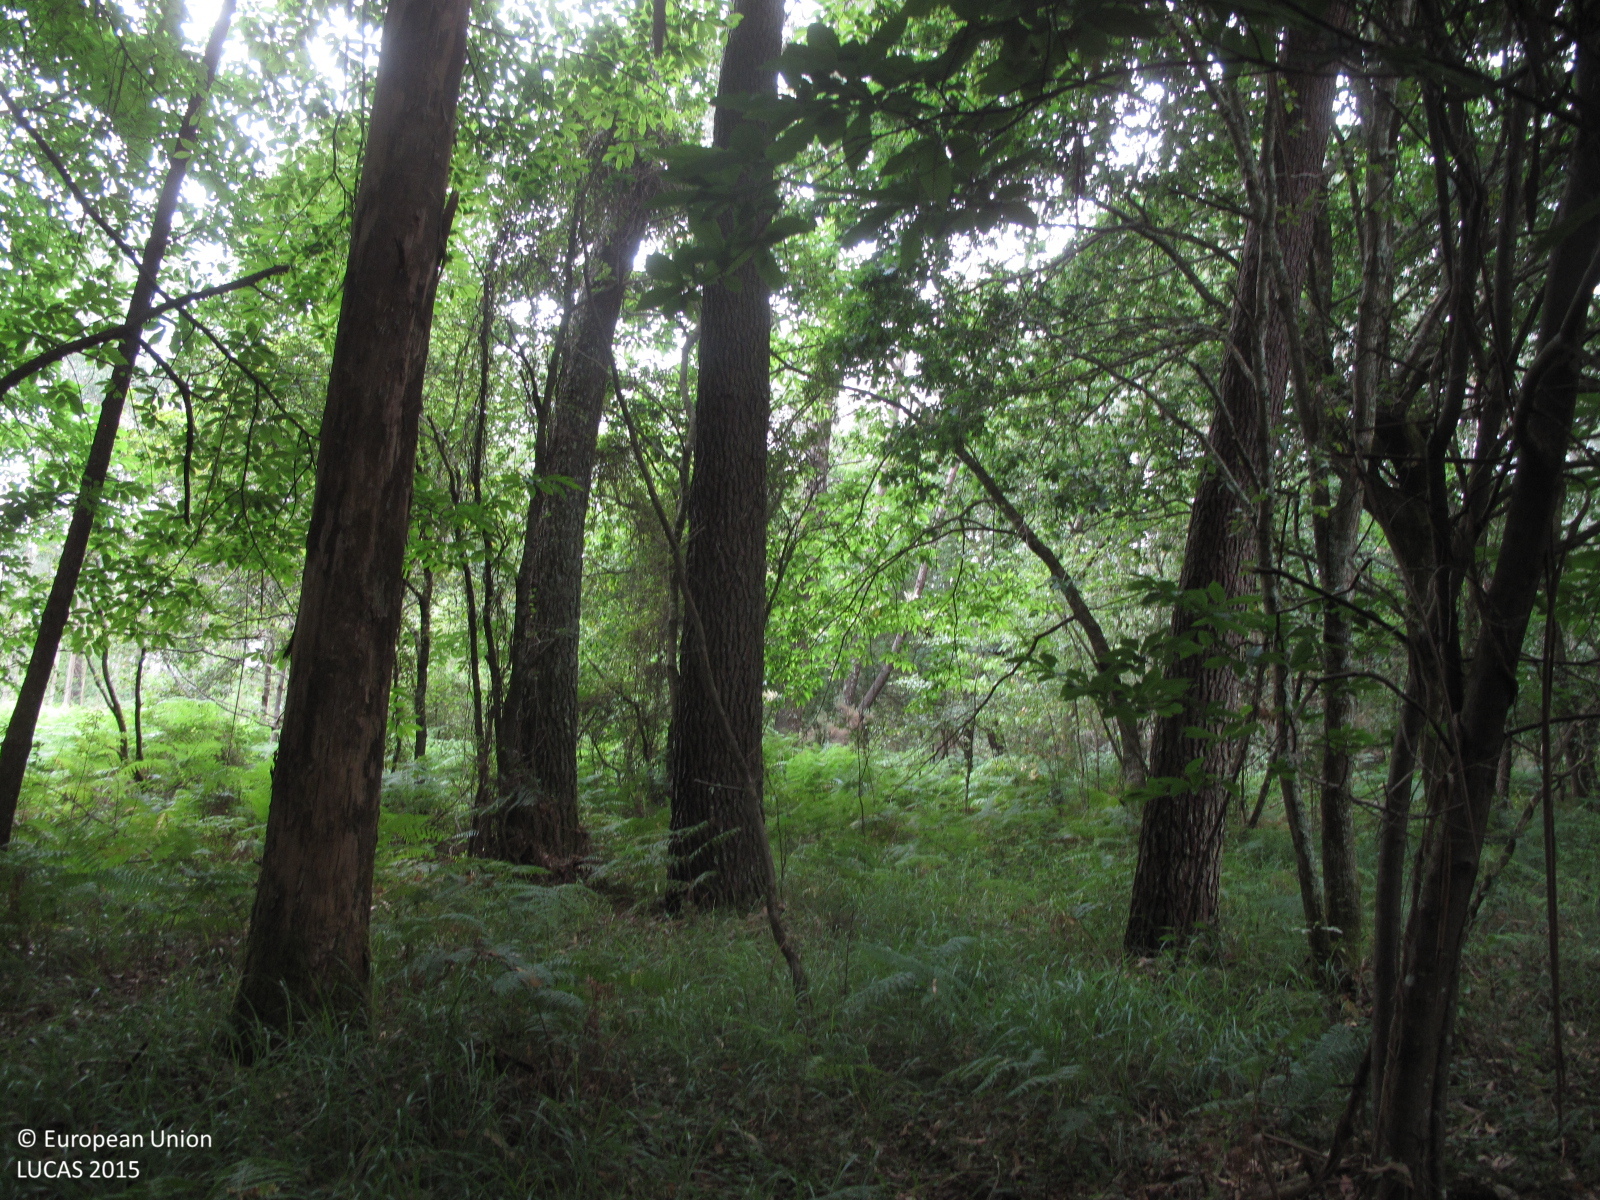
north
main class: Woodland
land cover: Broadleaved woodland
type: thermophilous deciduous forest
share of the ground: > 75 %
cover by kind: broadleaved forest trees 90 %, shrubs 5 %, herbaceous plants 5 %
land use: Forestry
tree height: > 5 m
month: July
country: ES
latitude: 43.3737
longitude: -8.1807
